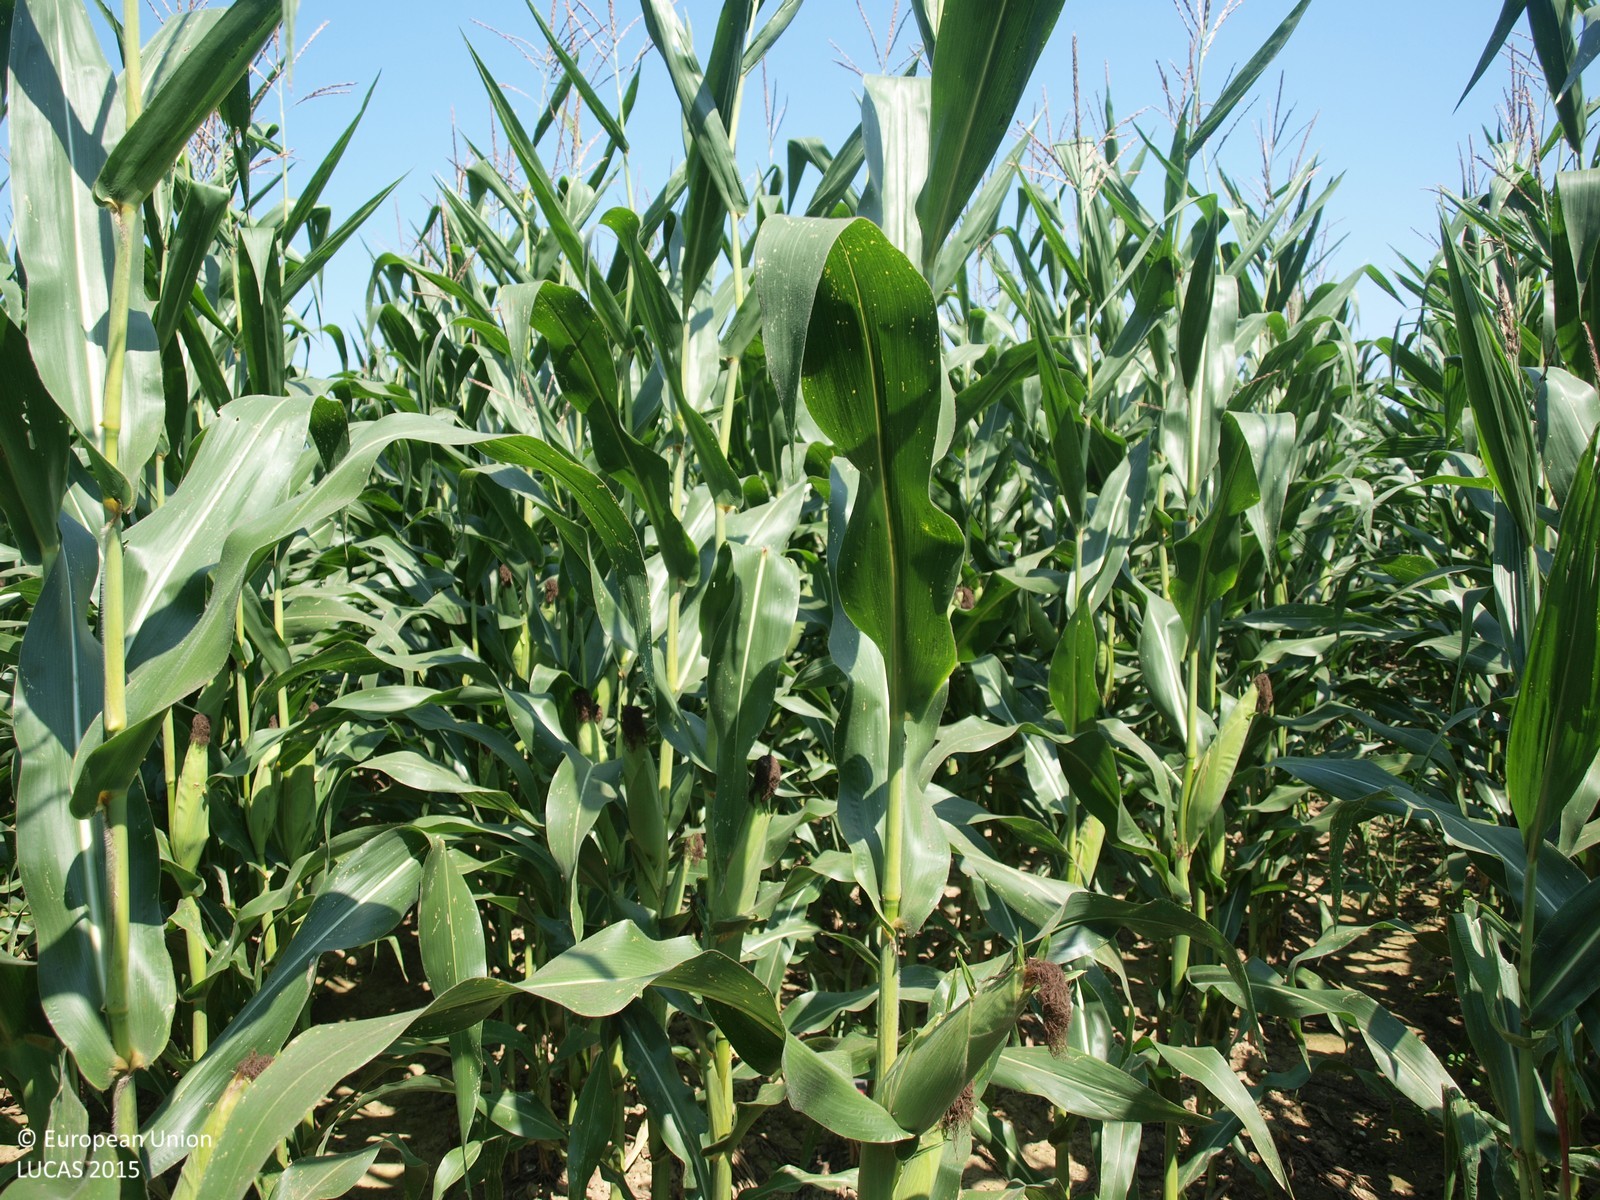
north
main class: Cropland
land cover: Maize
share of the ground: > 75 %
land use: Agriculture (excluding fallow land and kitchen gardens)
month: August
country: HR
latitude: 45.8968
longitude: 16.5598
